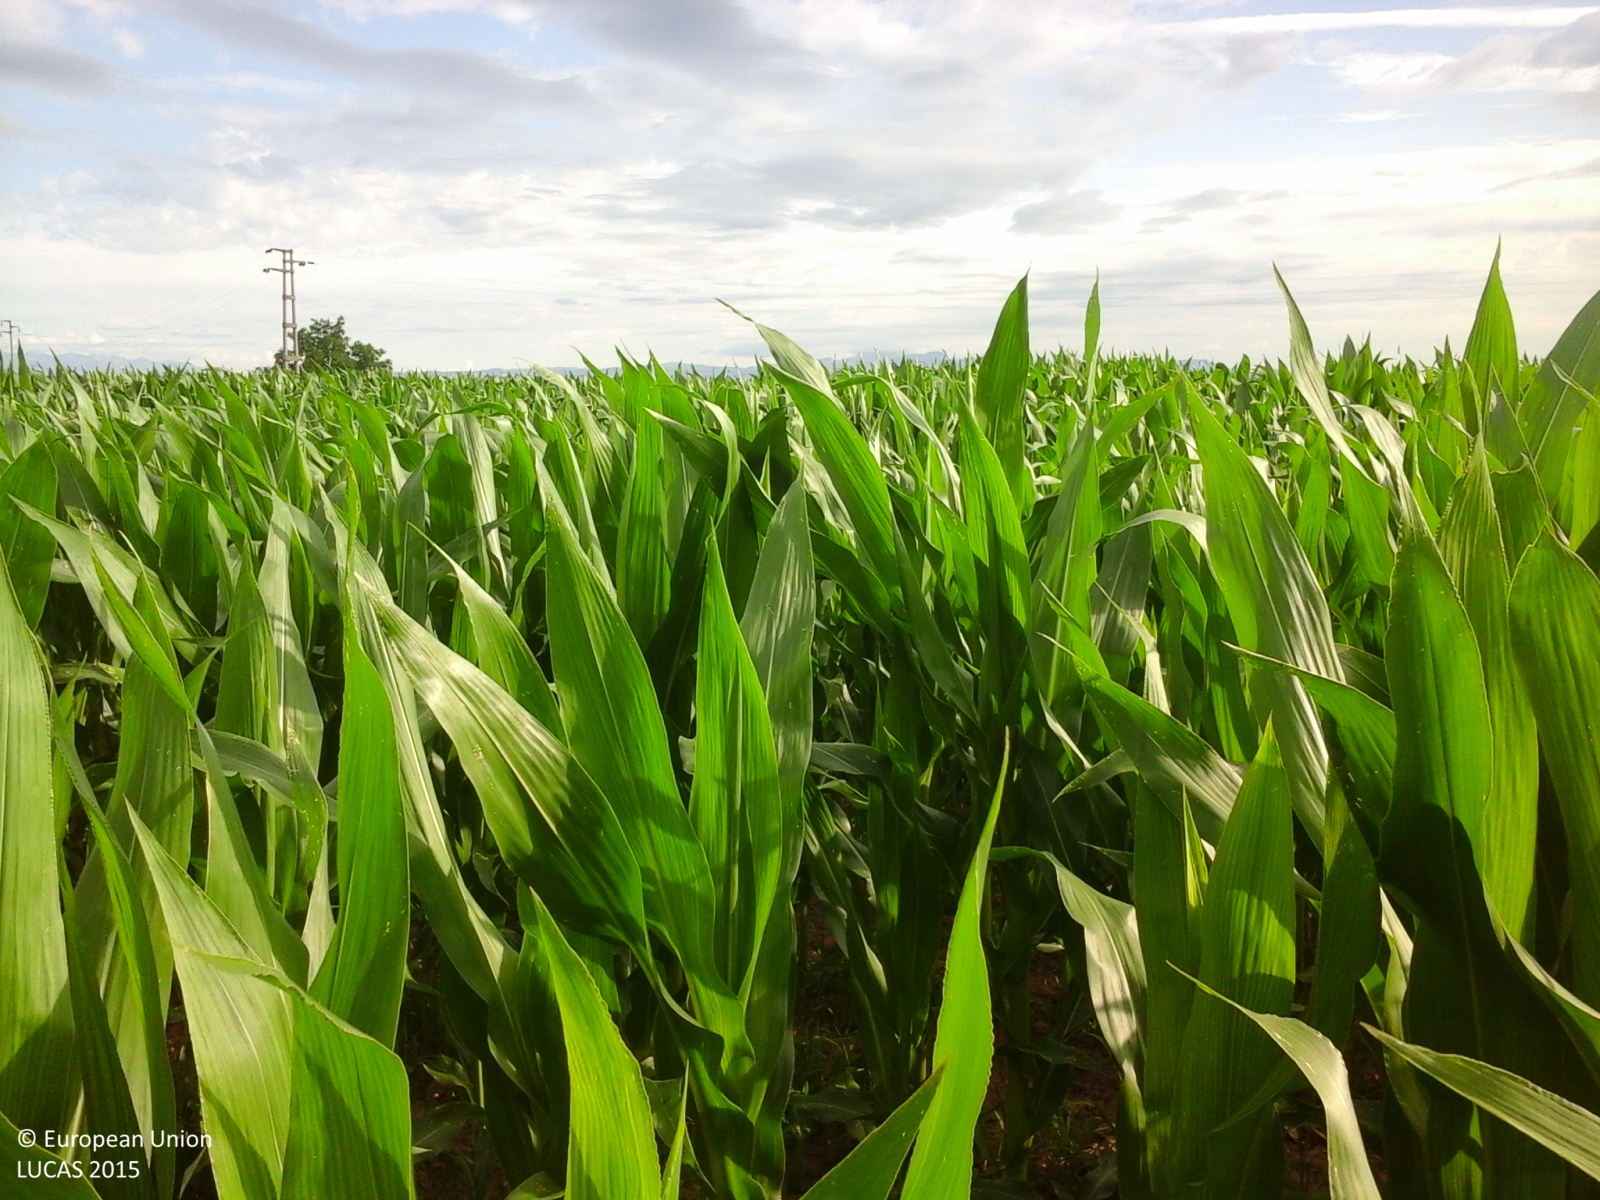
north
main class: Cropland
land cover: Maize
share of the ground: > 75 %
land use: Agriculture (excluding fallow land and kitchen gardens)
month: June
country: IT
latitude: 45.3361
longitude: 11.1337
